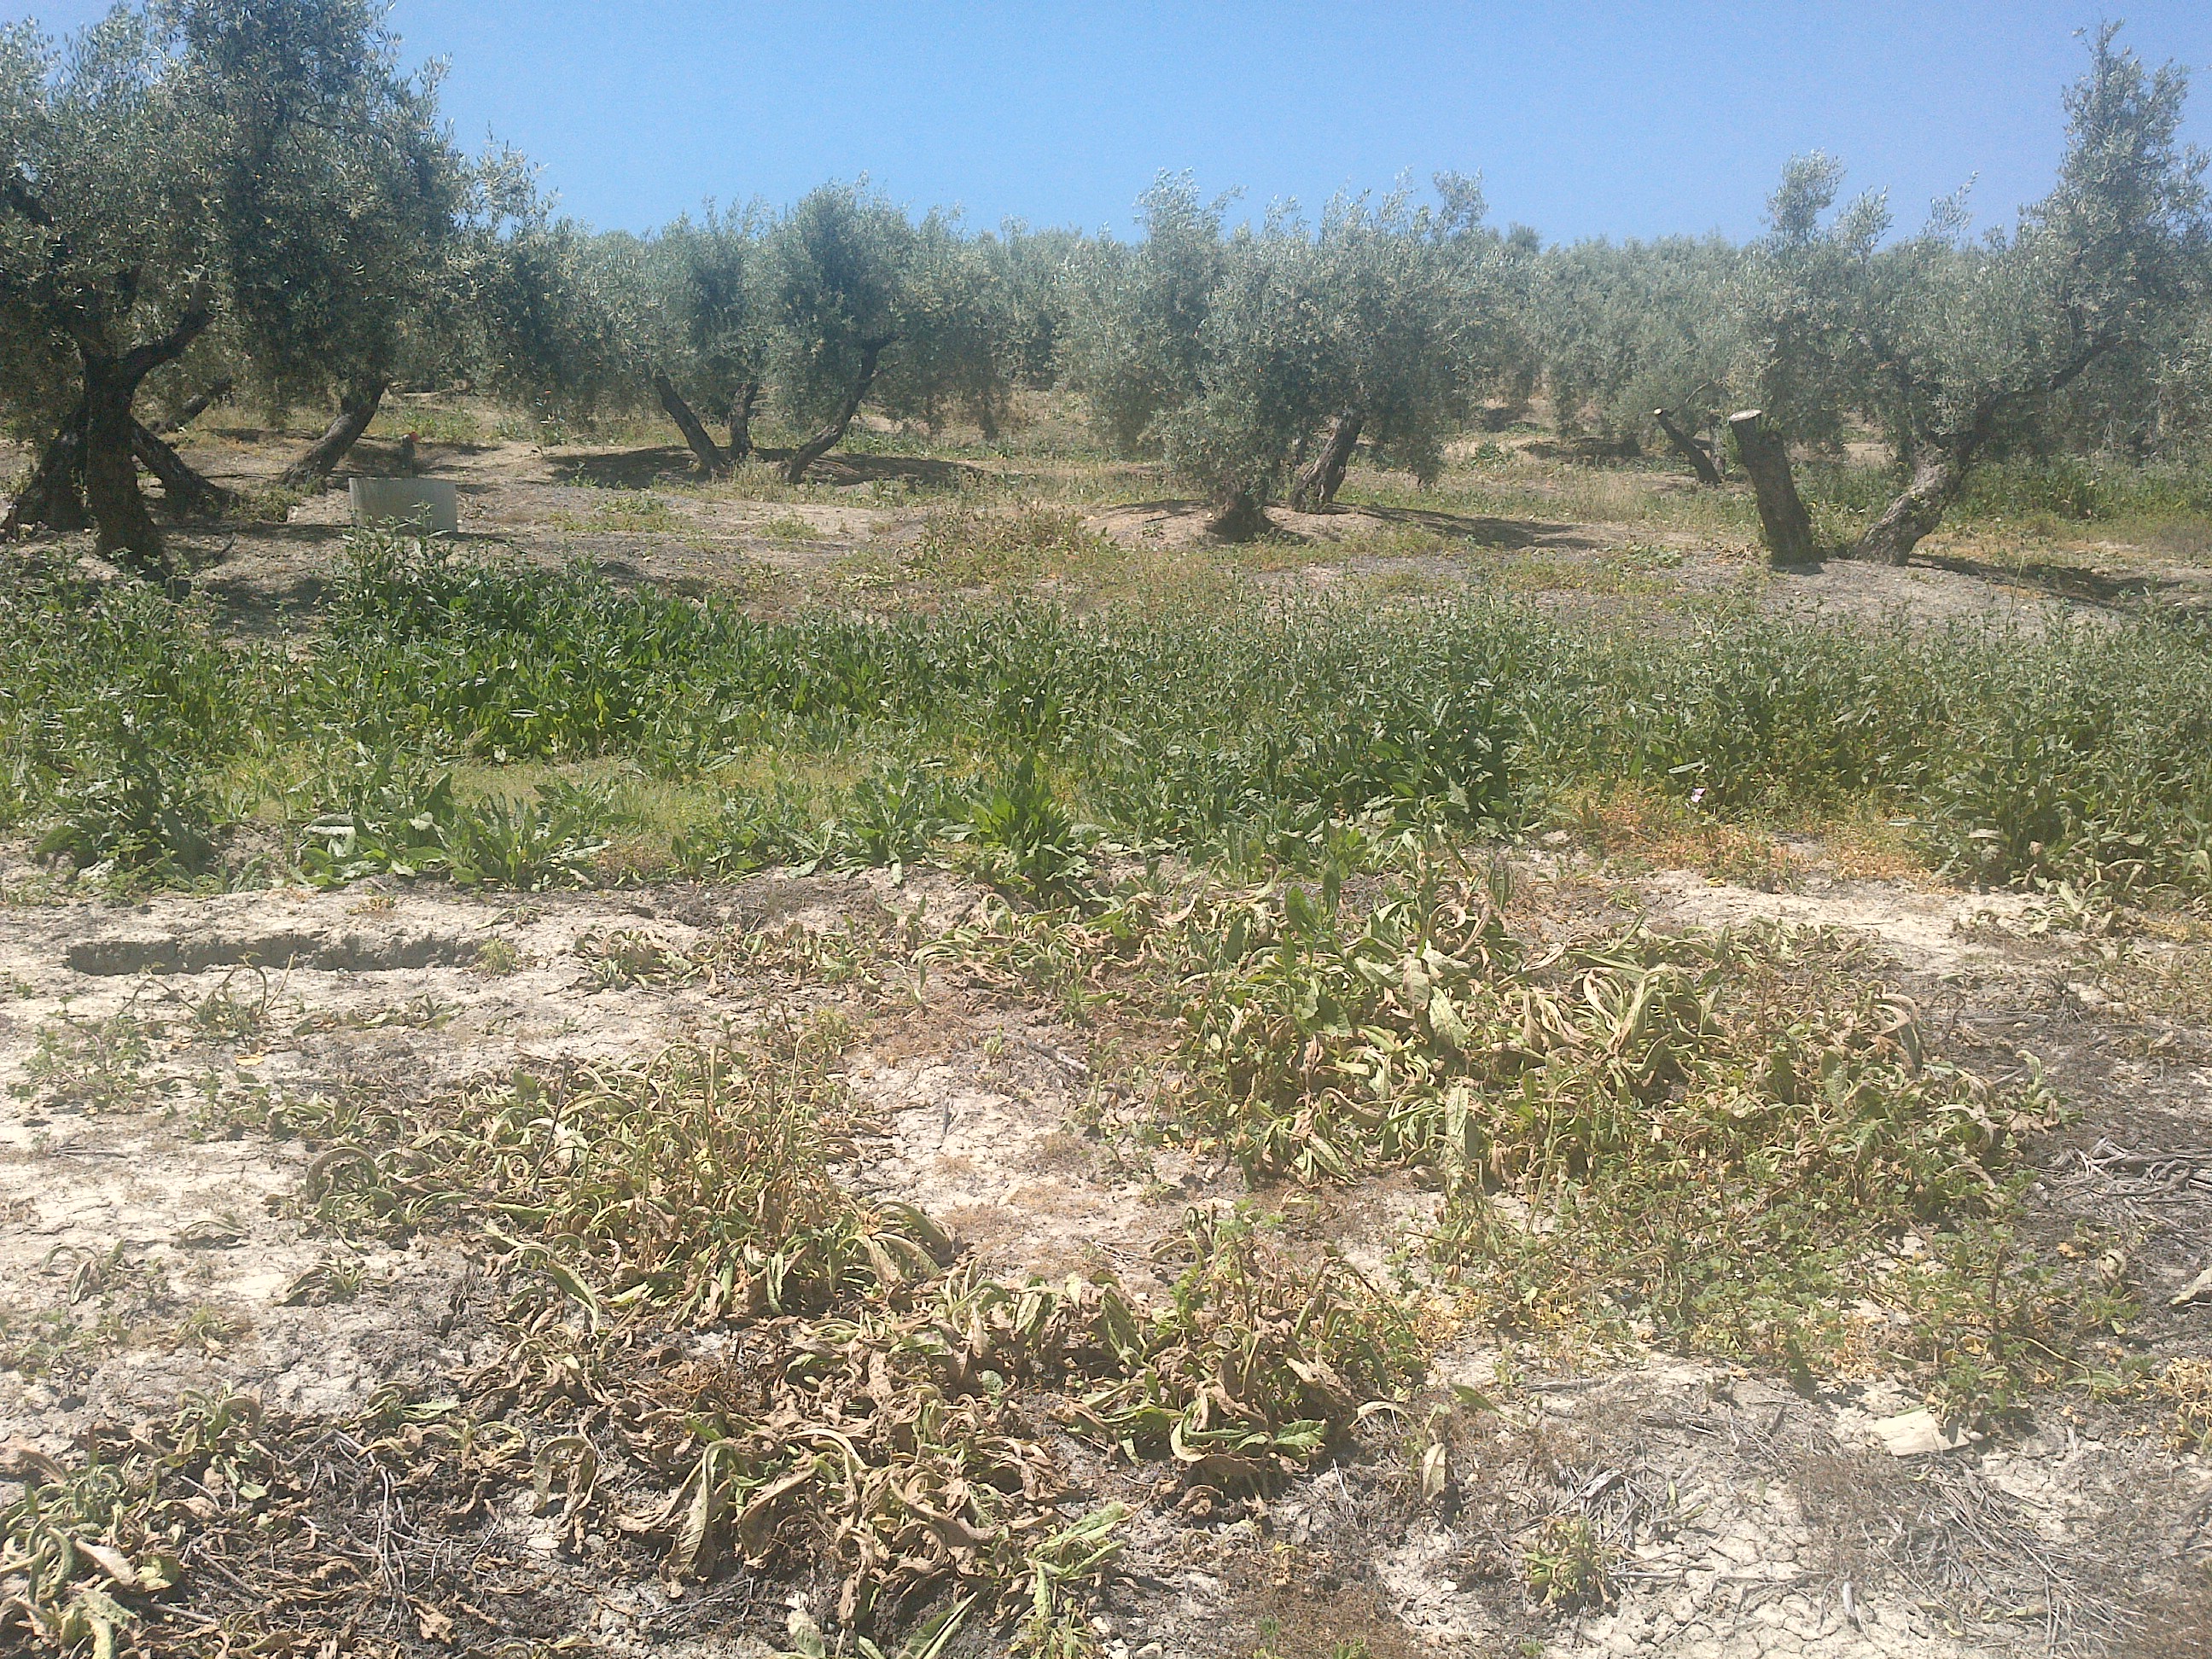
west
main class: Cropland
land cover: Olive groves
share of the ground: 25 - 50 %
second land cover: Spontaneously vegetated surfaces
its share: 10 - 25 %
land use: Agriculture (excluding fallow land and kitchen gardens)
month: May
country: ES
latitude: 37.6948
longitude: -4.6278
